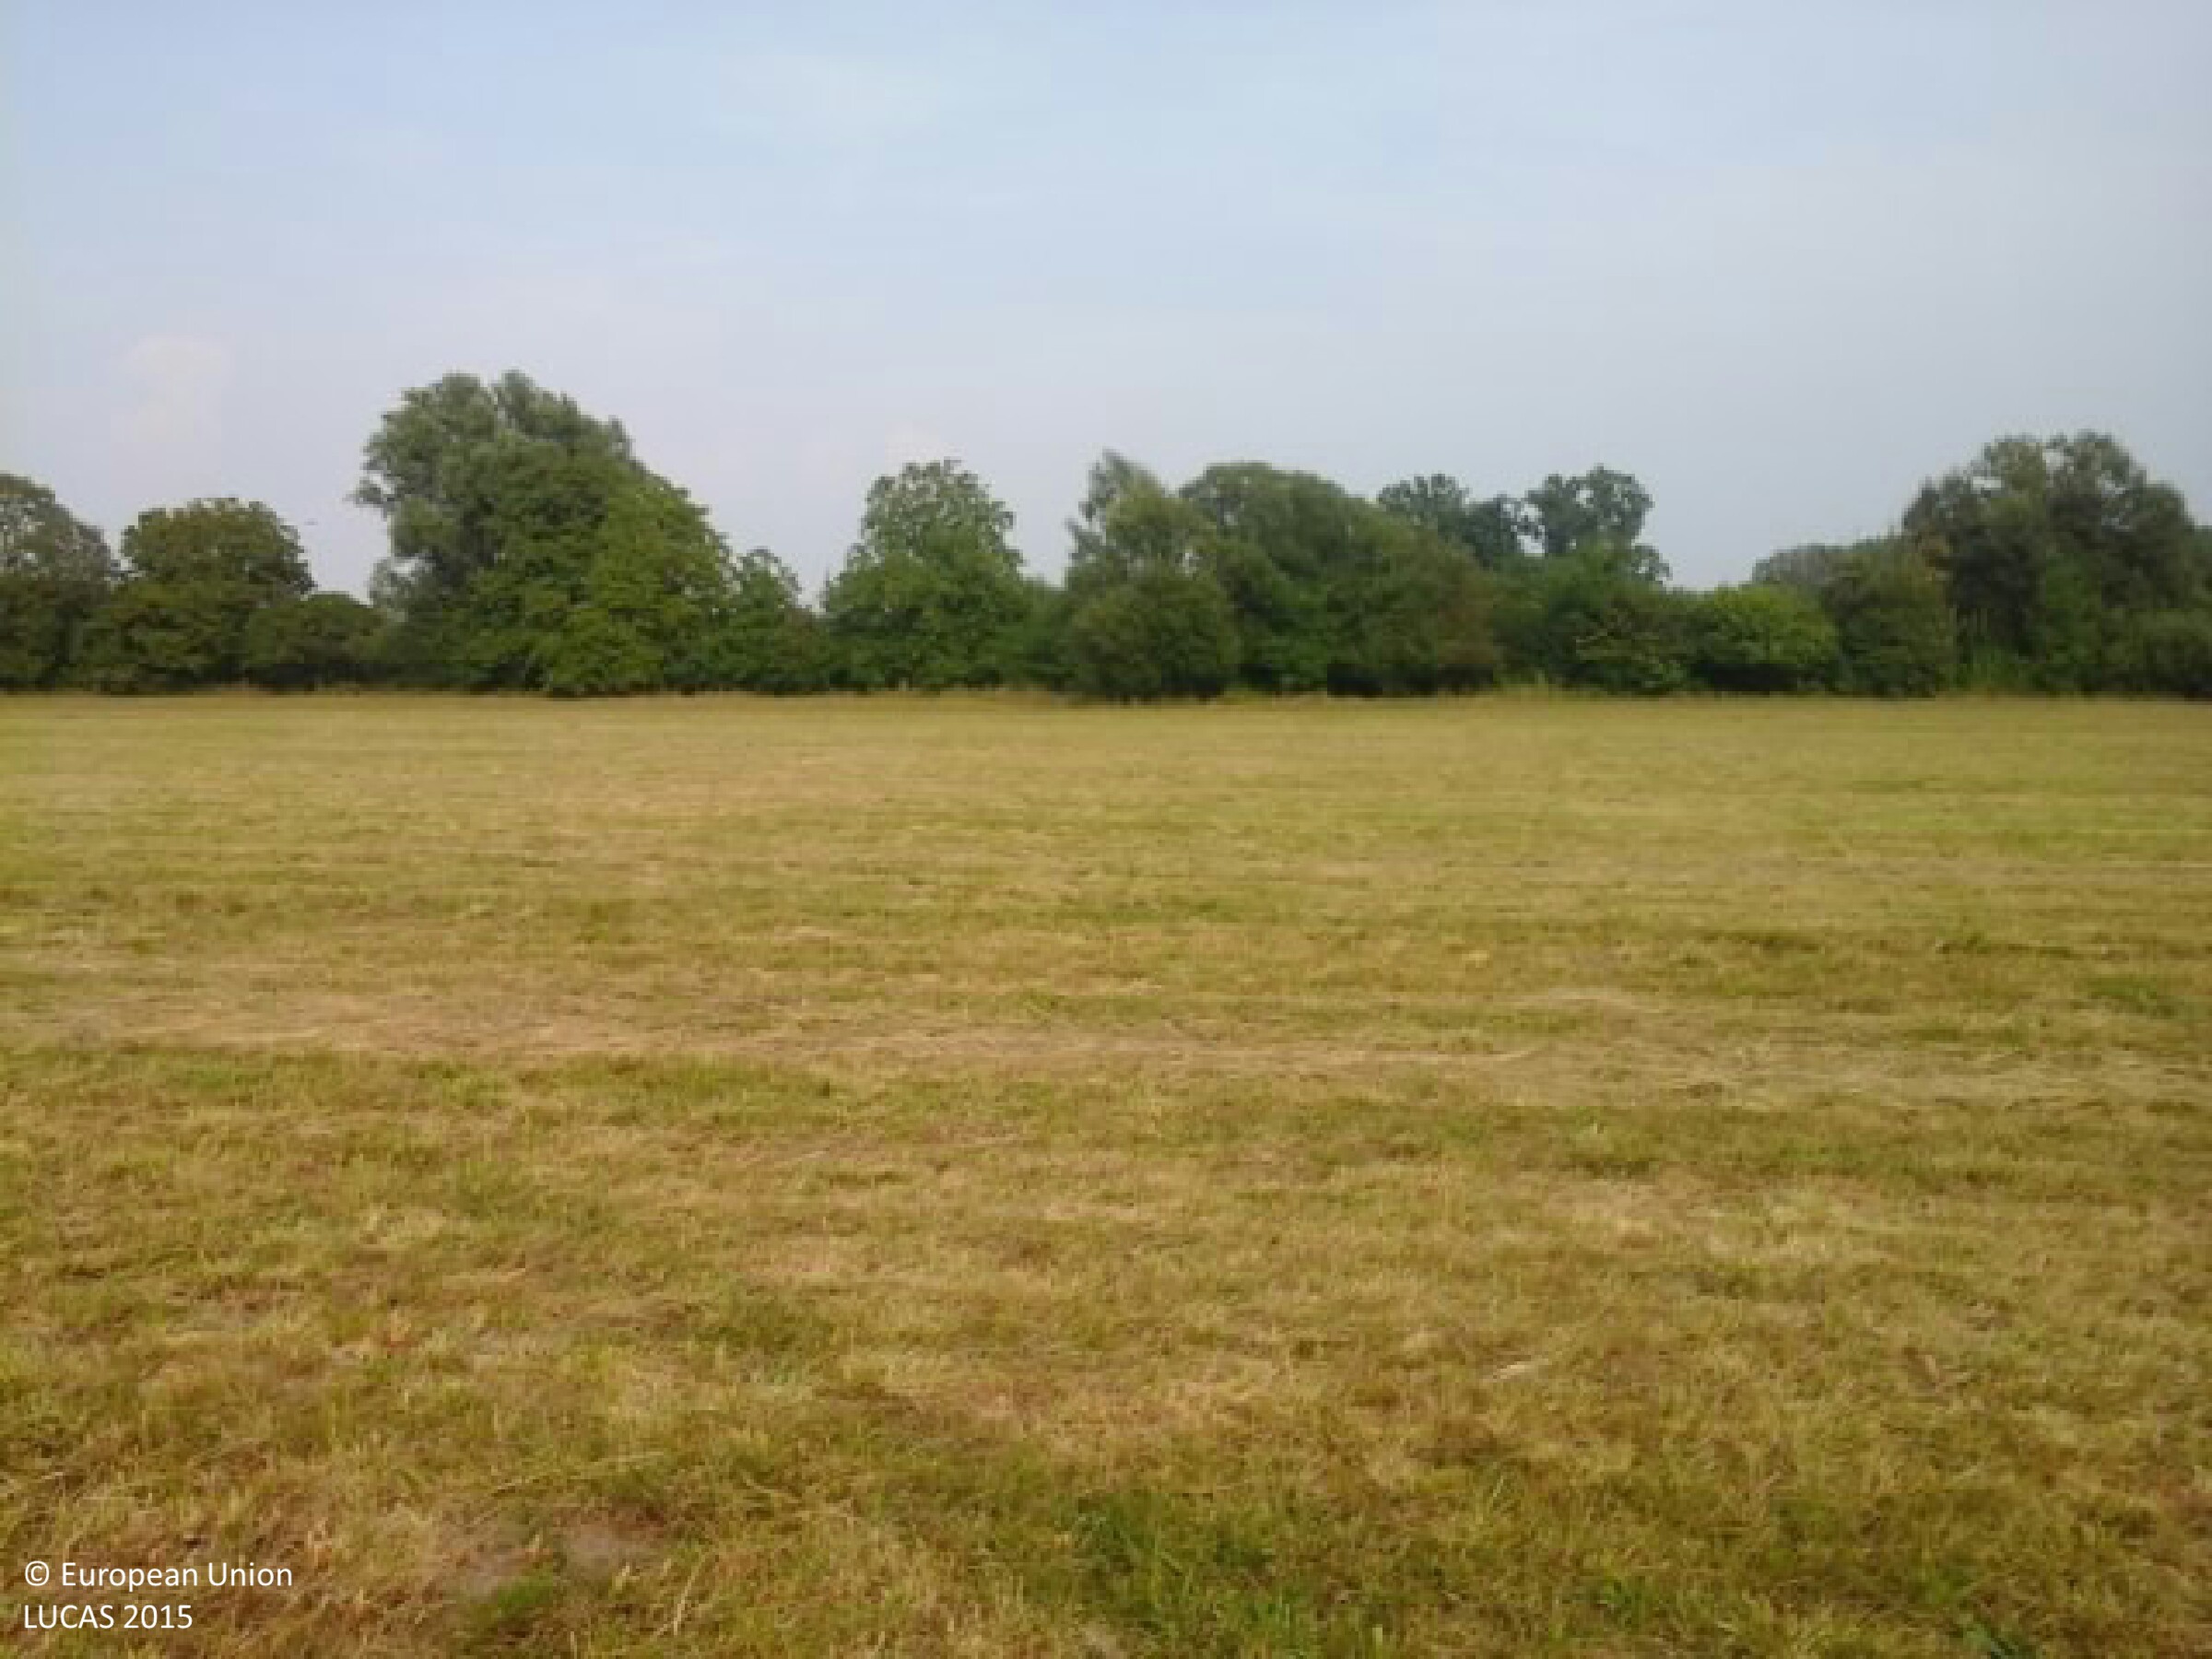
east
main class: Grassland
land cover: Grassland without tree/shrub cover
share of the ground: > 75 %
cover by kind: herbaceous plants 95 %, unconsolidated bare surface 5 %
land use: Agriculture (excluding fallow land and kitchen gardens)
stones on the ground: < 10 %
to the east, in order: Grassland without tree/shrub cover; Broadleaved woodland; Ditches and canals; Grassland without tree/shrub cover; Maize; Electric lines; Maize
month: August
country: HU
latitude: 46.5448
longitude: 17.1631
